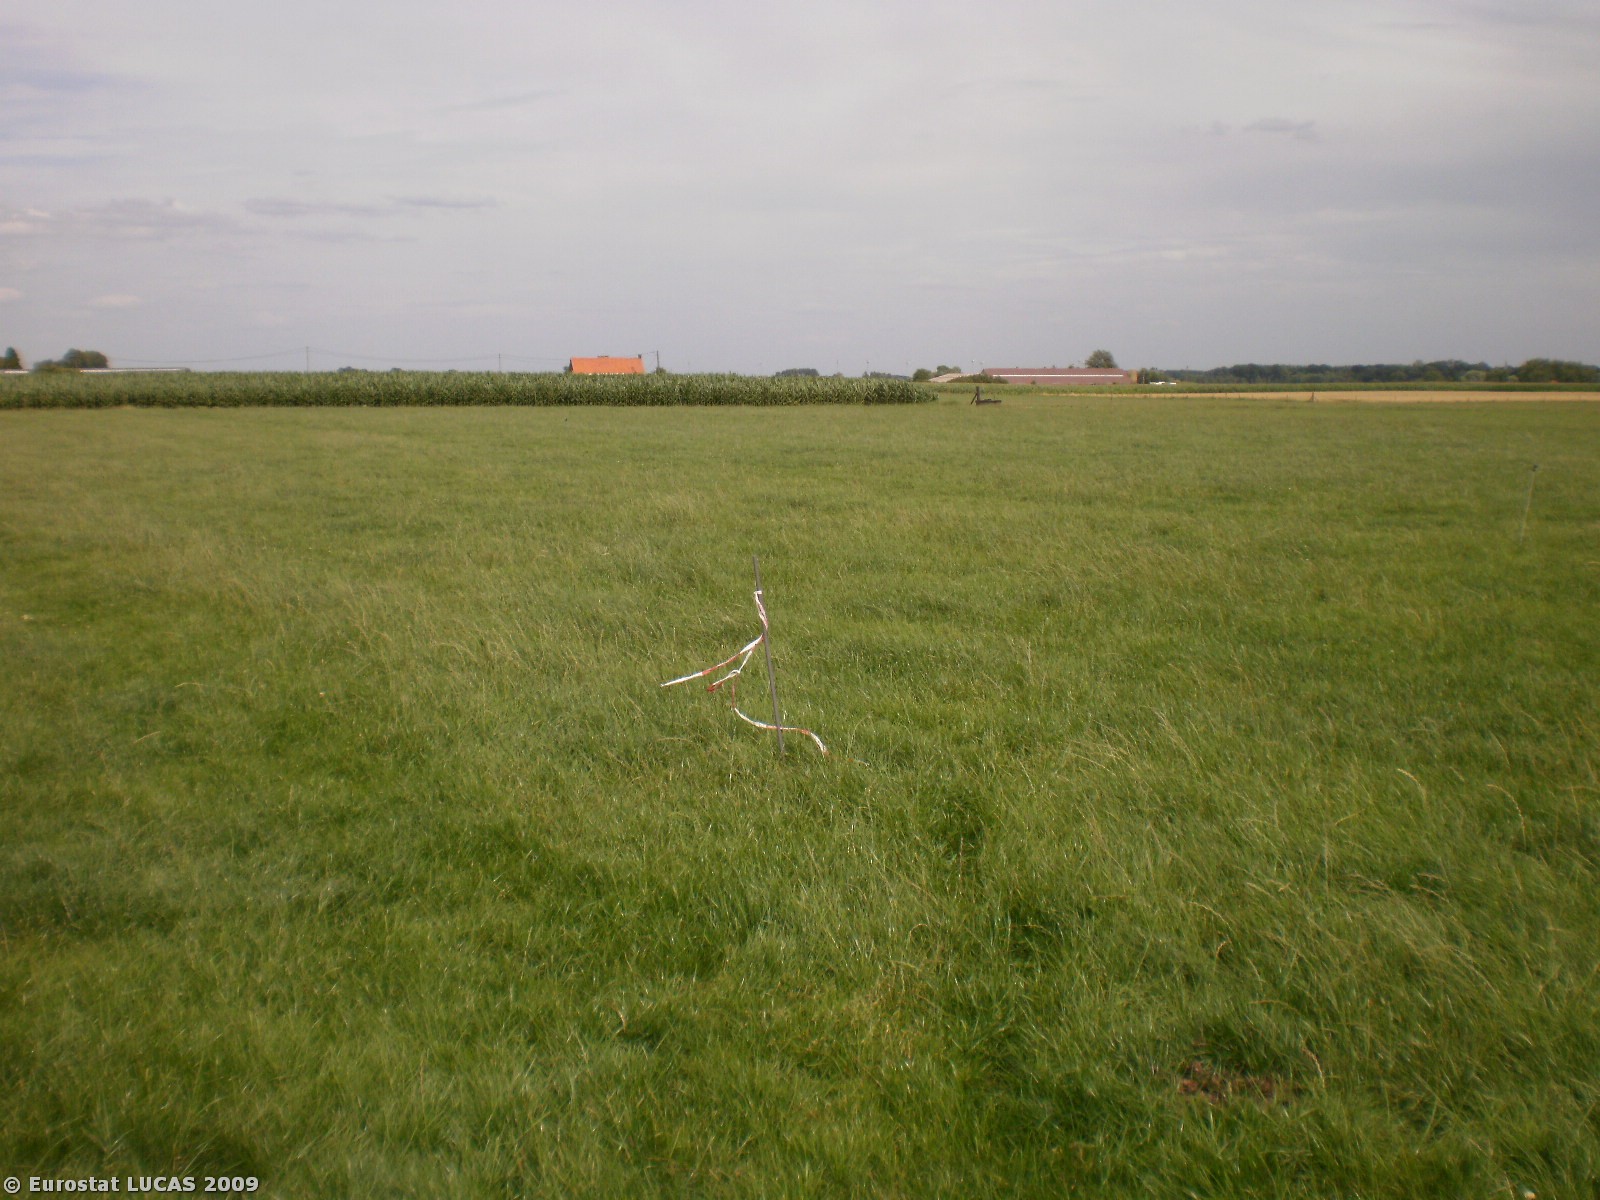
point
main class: Grassland
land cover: Grassland without tree/shrub cover
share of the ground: > 75 %
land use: Agriculture (excluding fallow land and kitchen gardens)
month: July
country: BE
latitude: 50.8583
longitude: 2.7862
